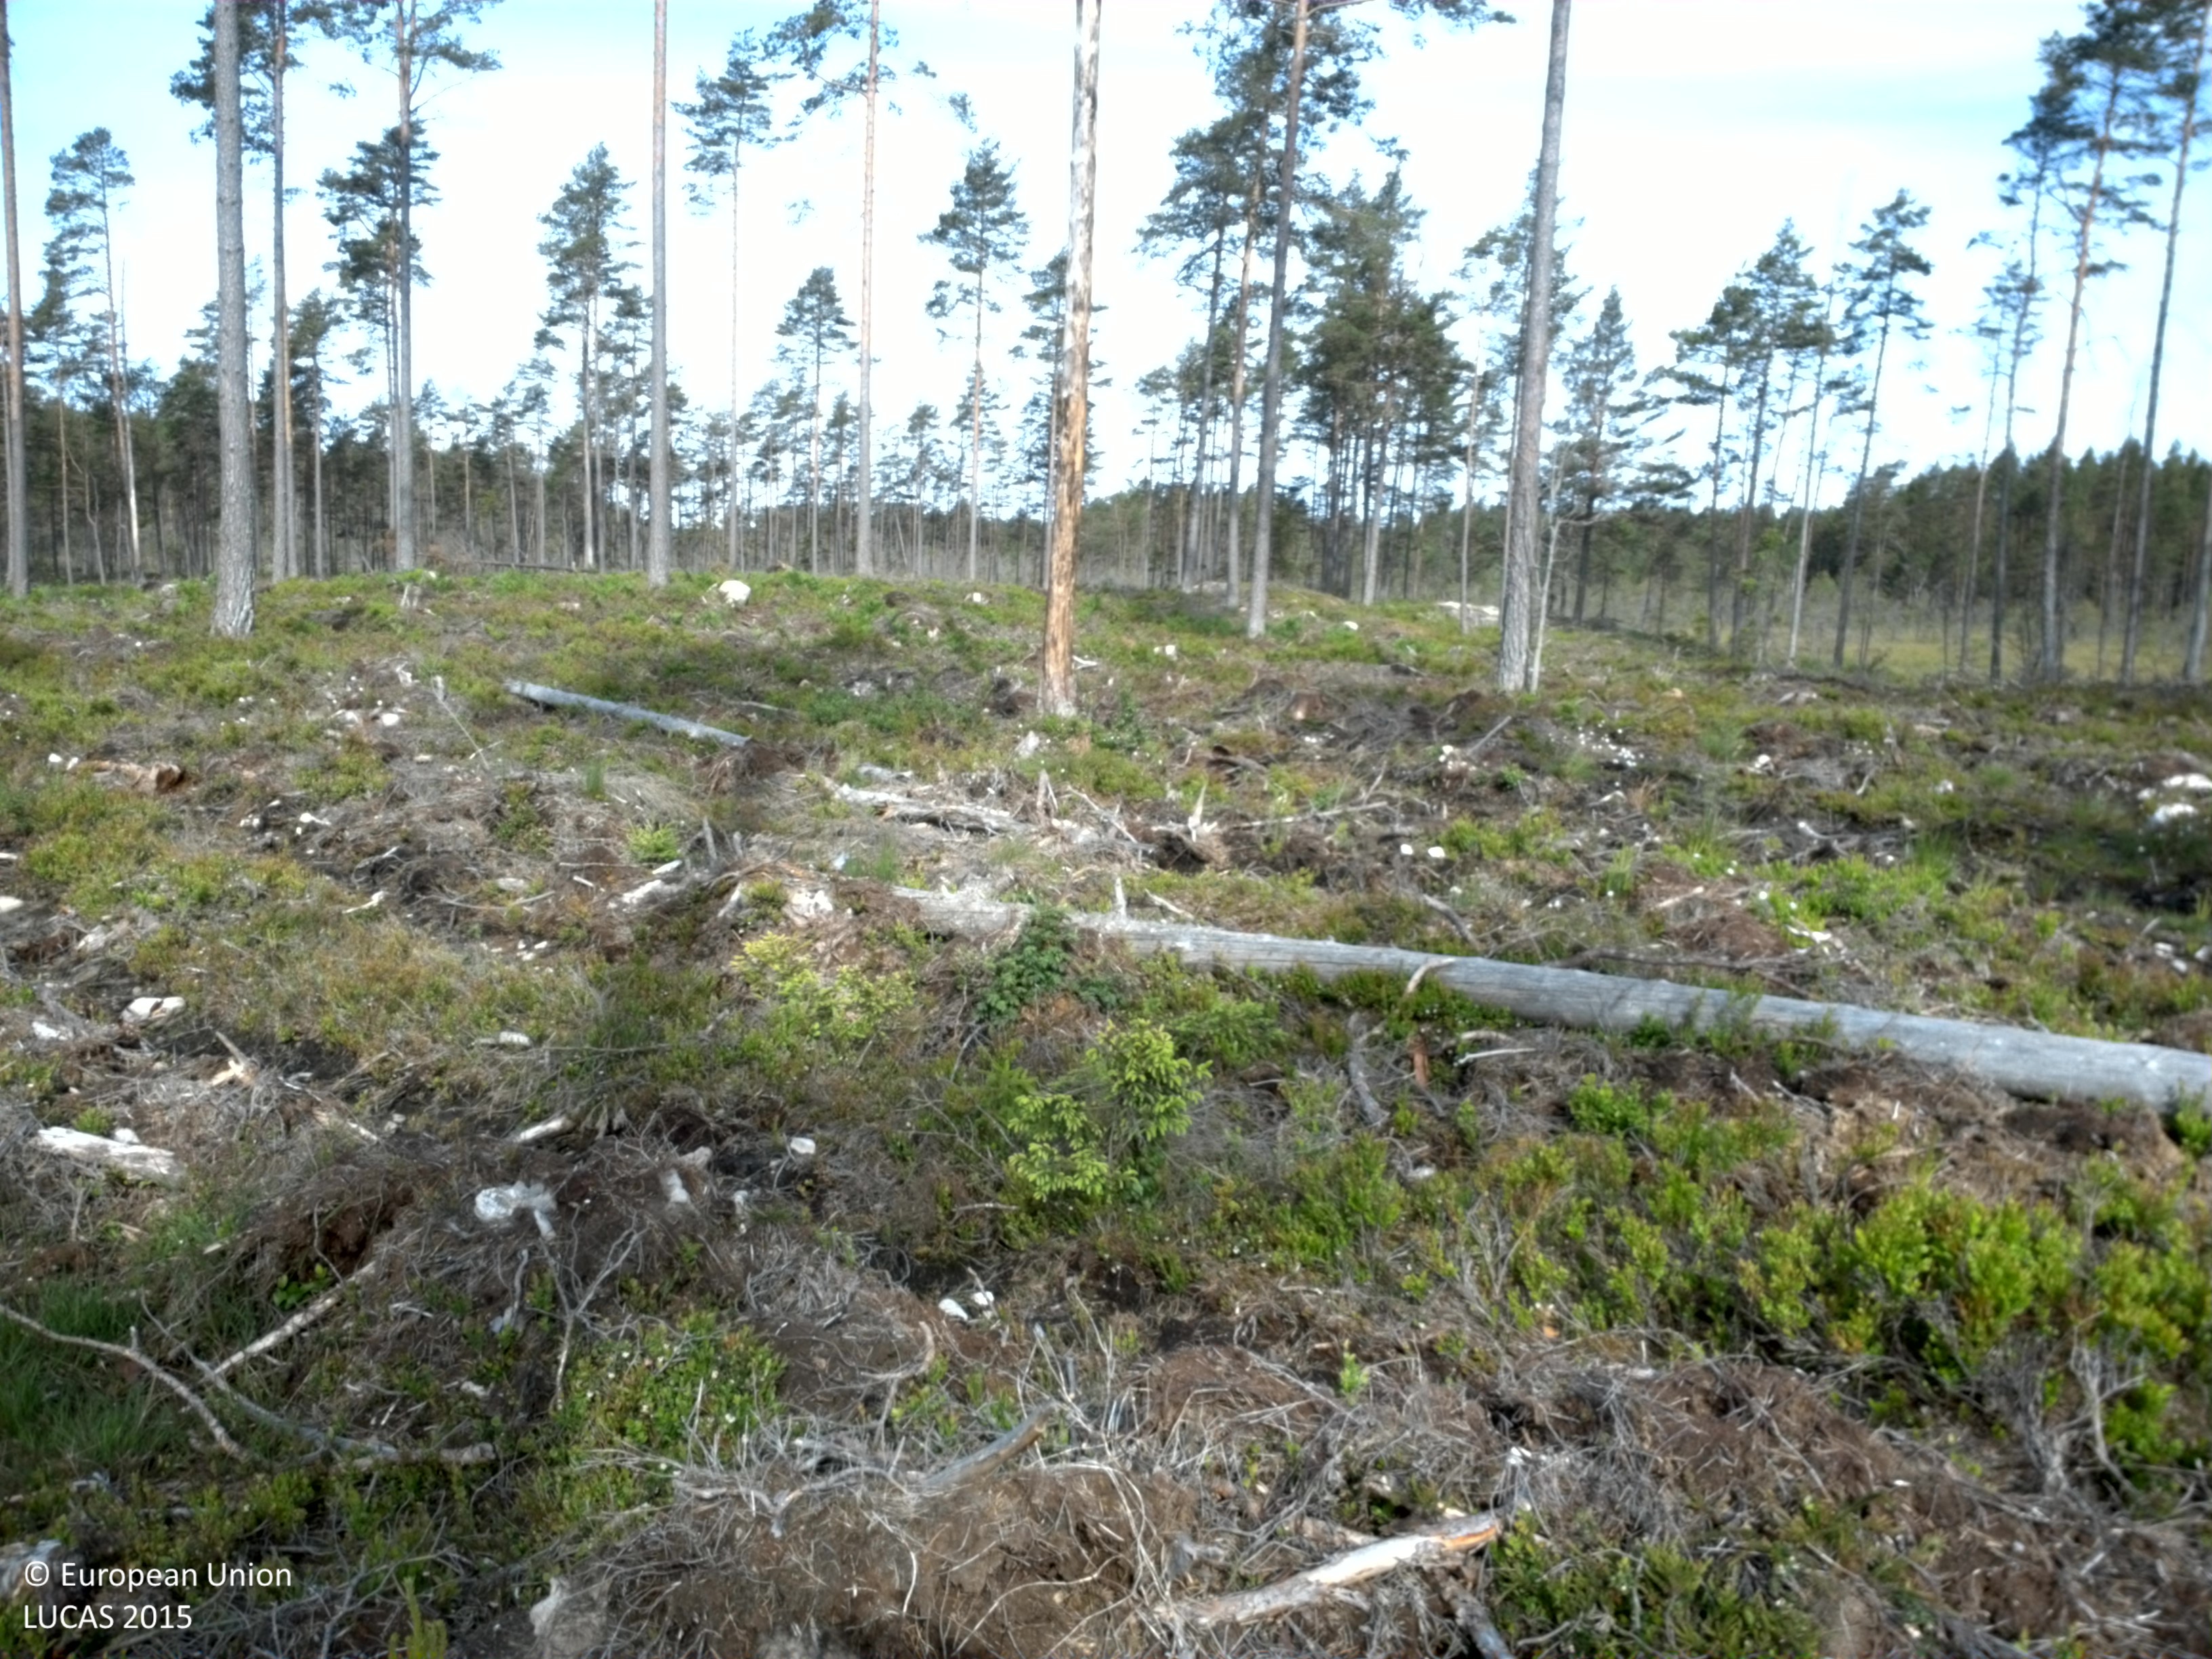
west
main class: Woodland
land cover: Pine dominated coniferous woodland
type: boreal forest
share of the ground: 10 - 25 %
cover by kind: shrubs 50 %, coniferous forest trees 15 %, consolidated bare surface 15 %, herbaceous plants 10 %, broadleaved forest trees 5 %, lichens and mosses 5 %
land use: Forestry
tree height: > 5 m
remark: Clear cut
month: June
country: SE
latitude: 58.6730
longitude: 16.5657
